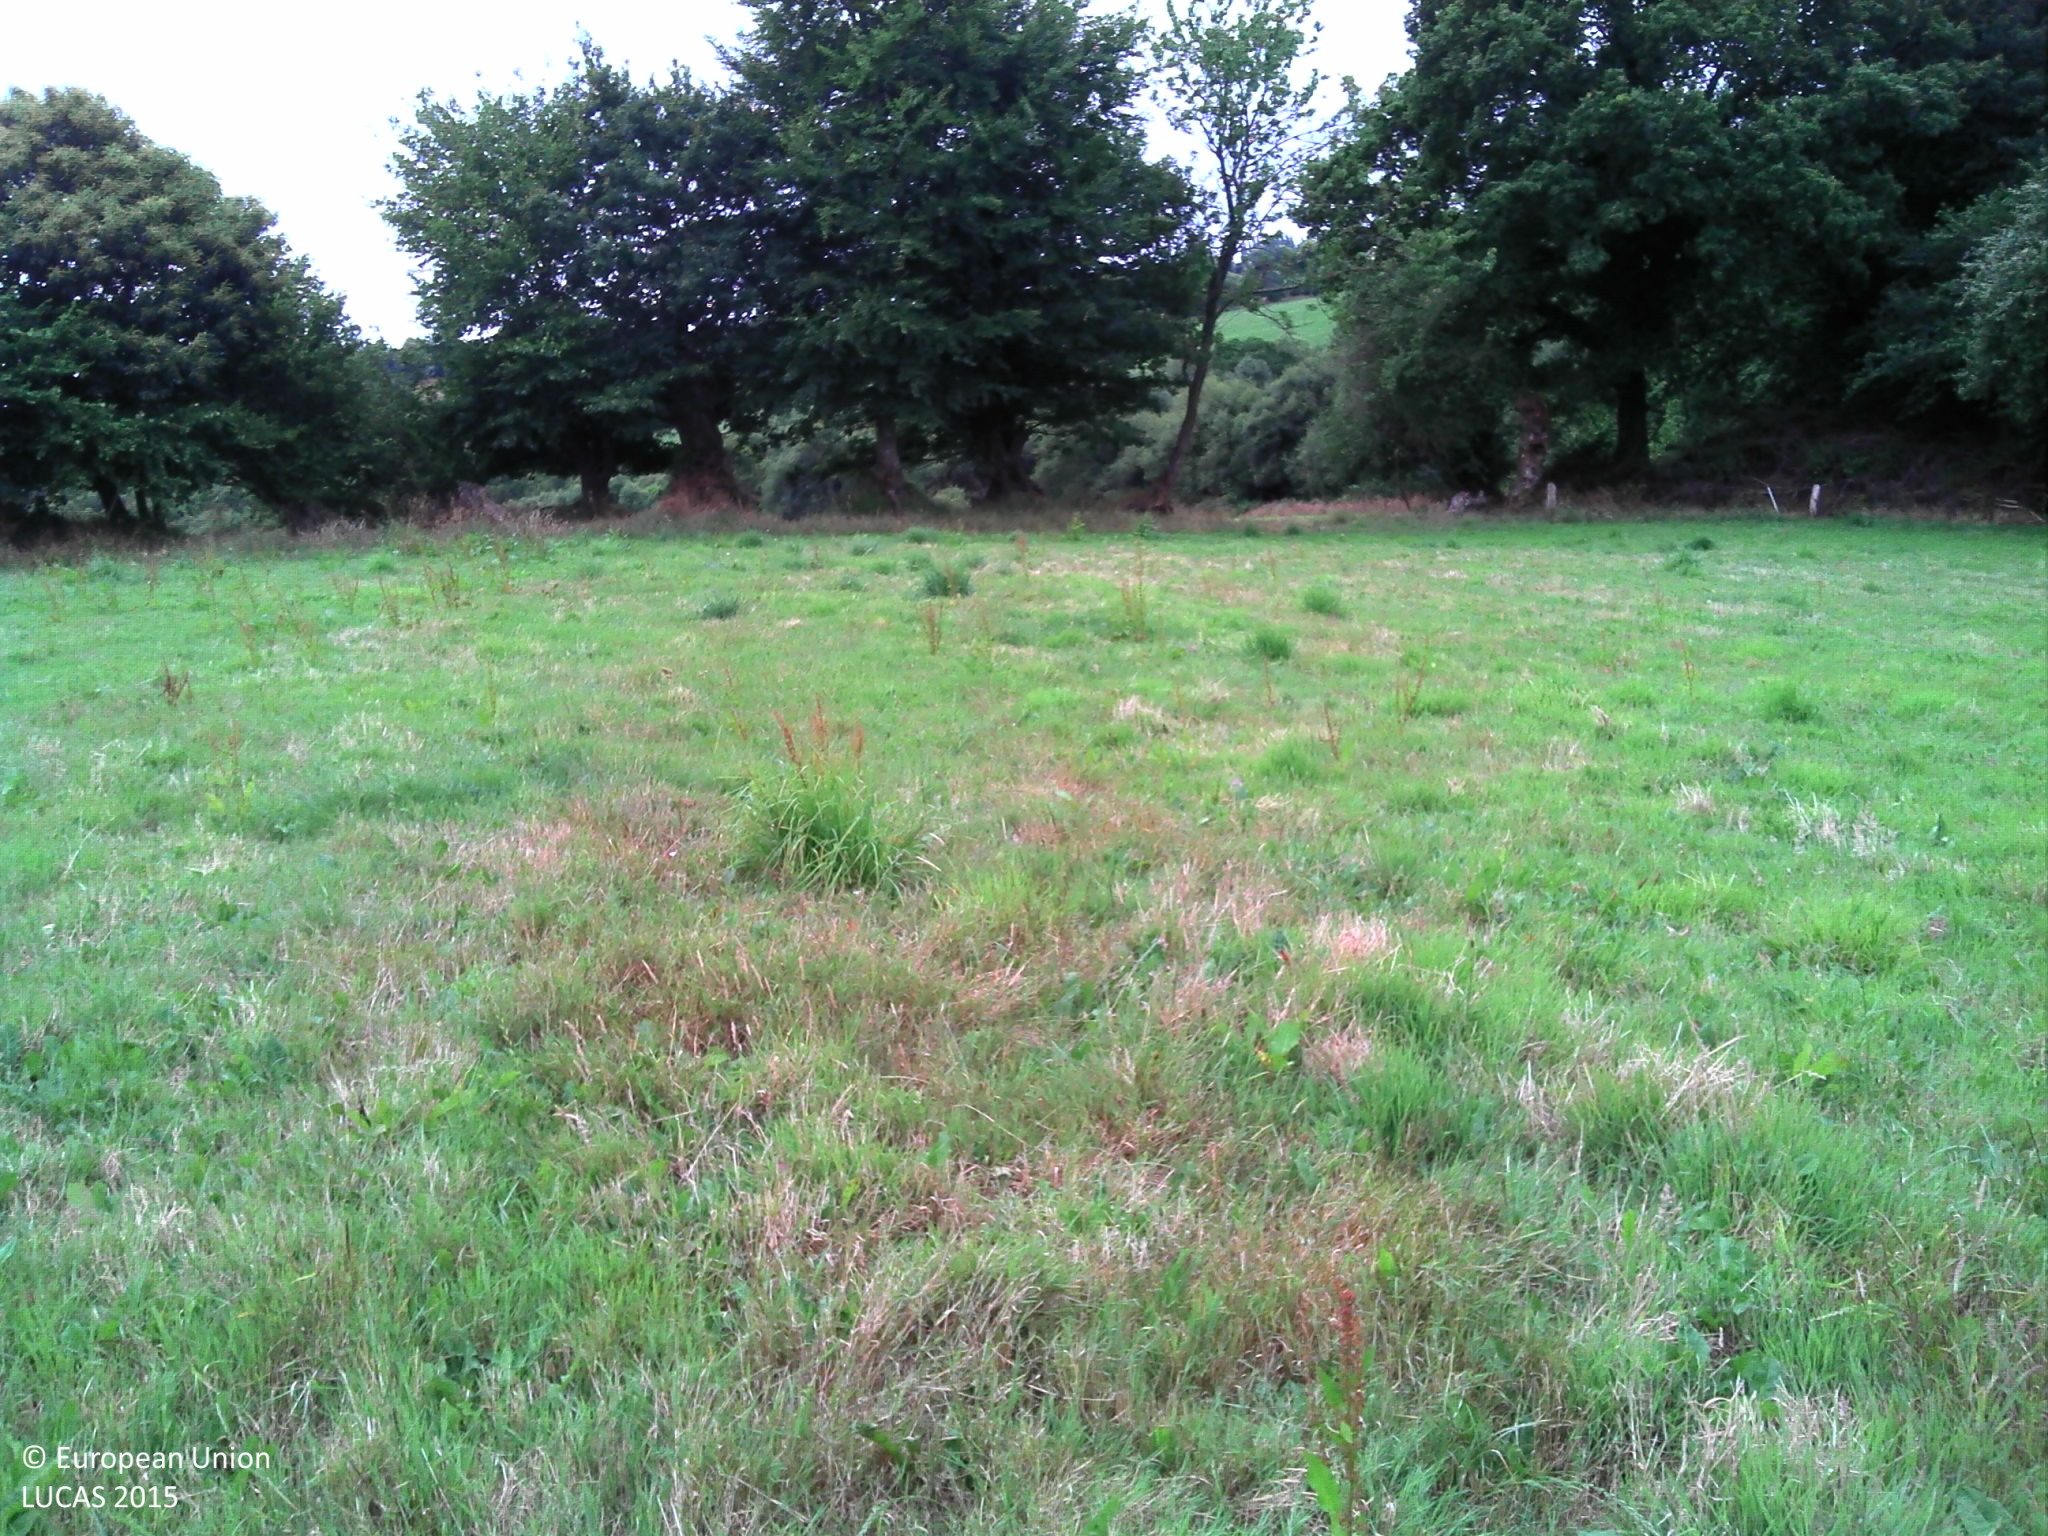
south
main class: Grassland
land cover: Grassland without tree/shrub cover
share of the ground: > 75 %
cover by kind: herbaceous plants 100 %
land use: Agriculture (excluding fallow land and kitchen gardens)
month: July
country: FR
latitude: 48.0987
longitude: -3.6559
